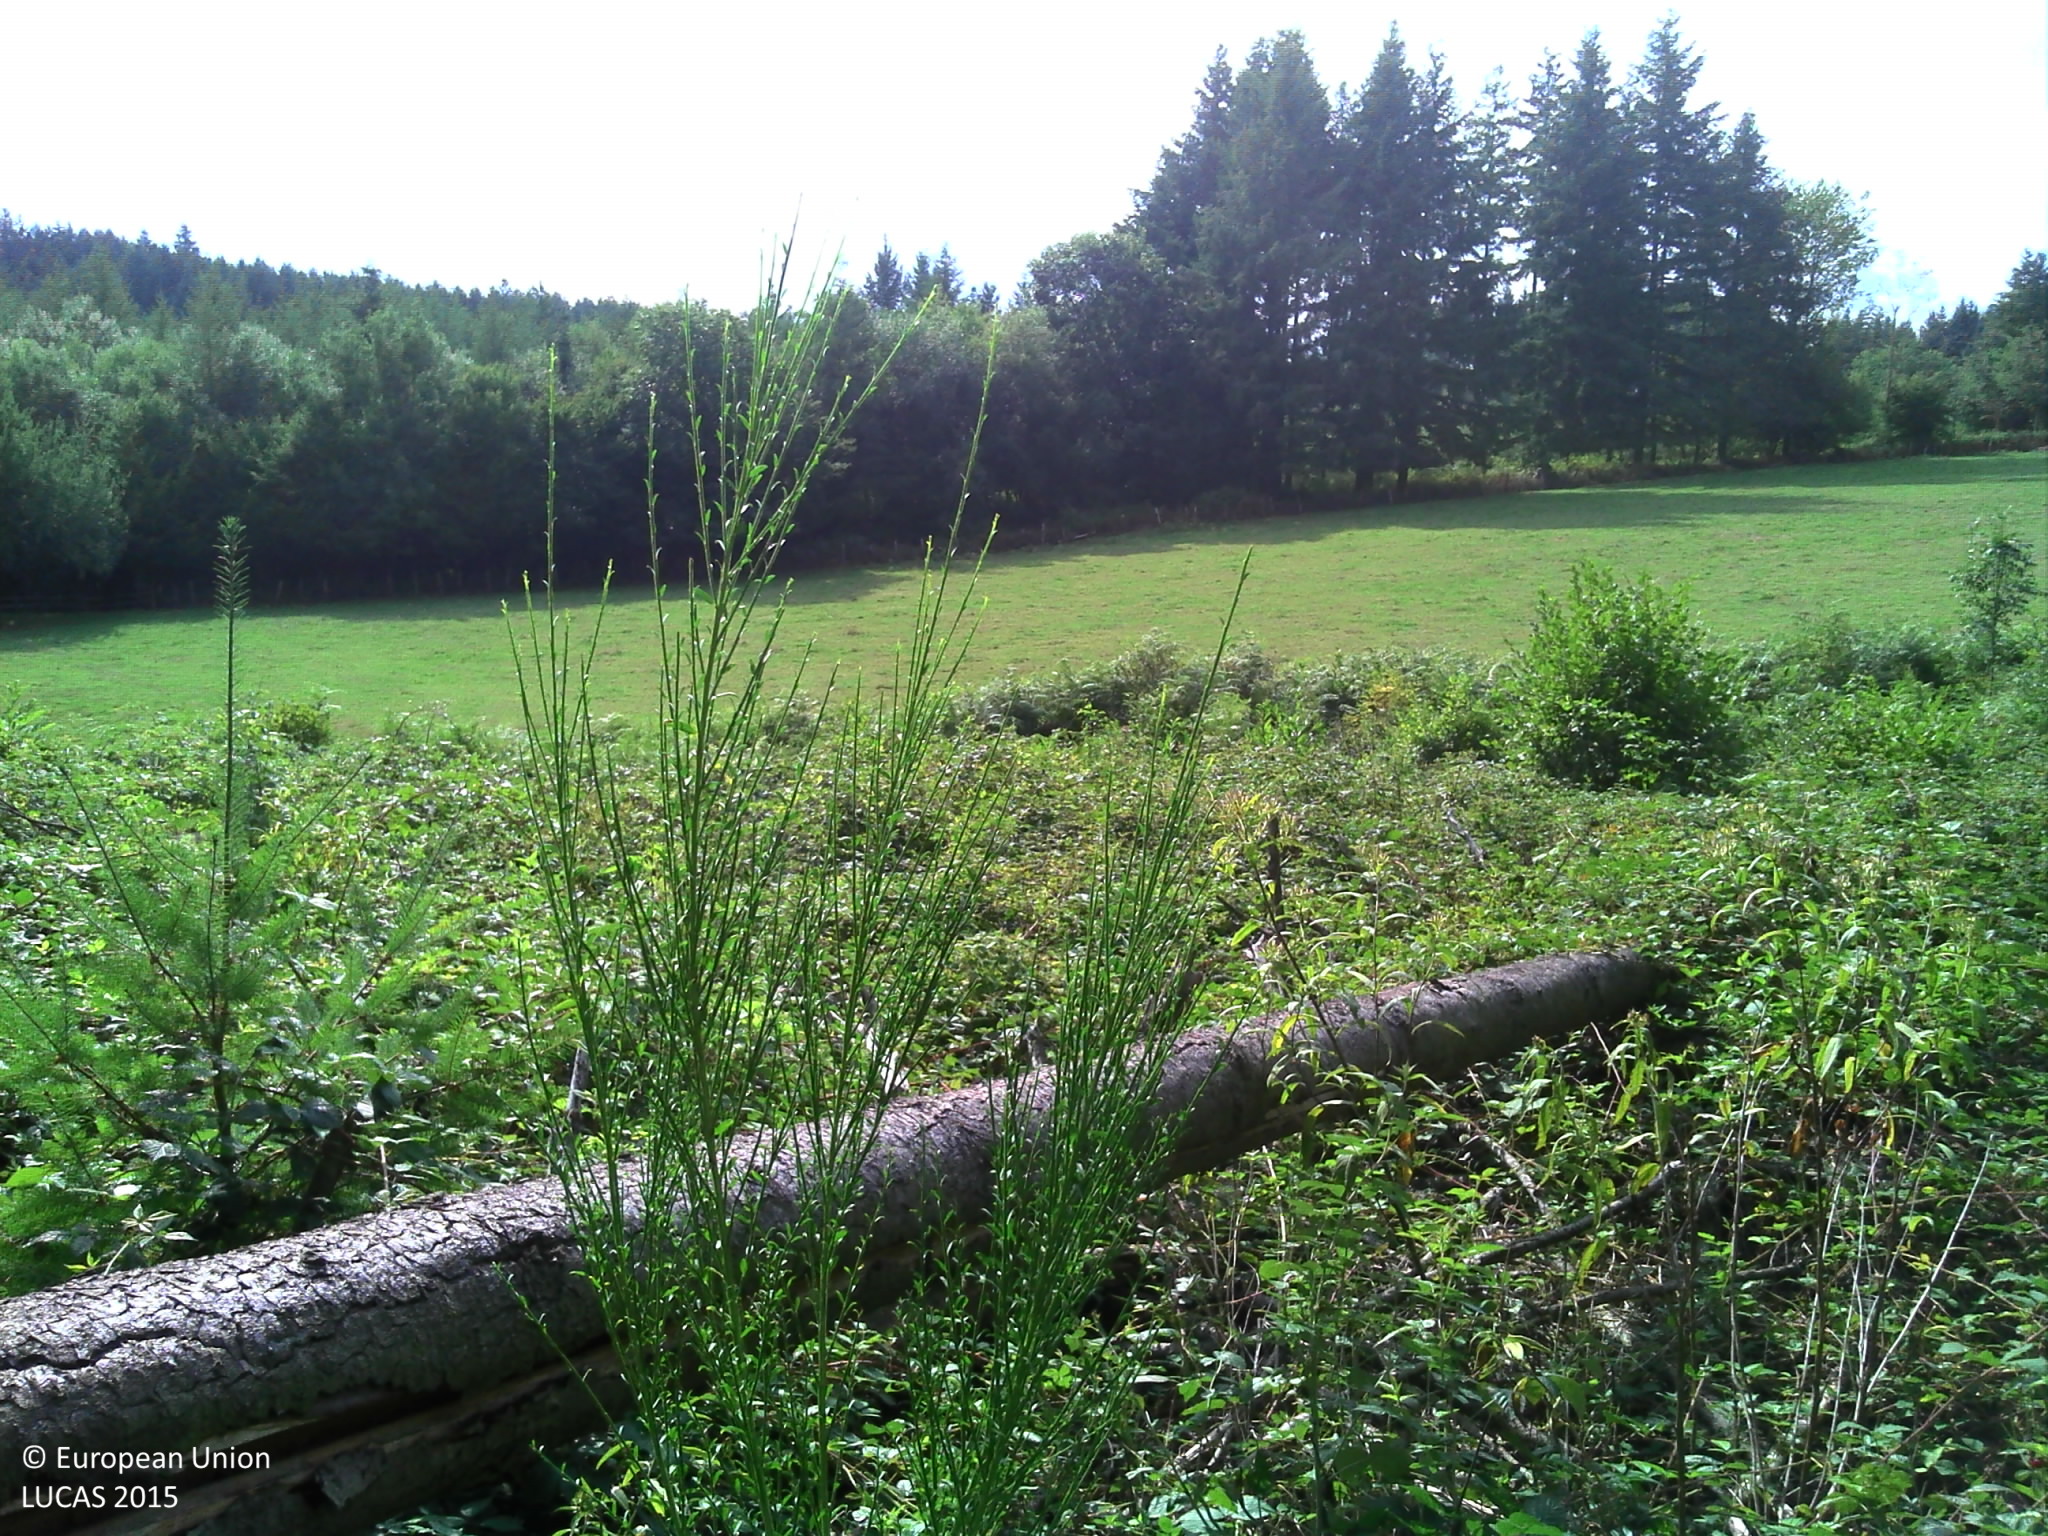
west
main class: Shrubland
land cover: Shrubland without tree cover
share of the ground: > 75 %
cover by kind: shrubs 80 %, herbaceous plants 20 %
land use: Forestry
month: August
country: FR
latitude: 46.2951
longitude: 4.4066
